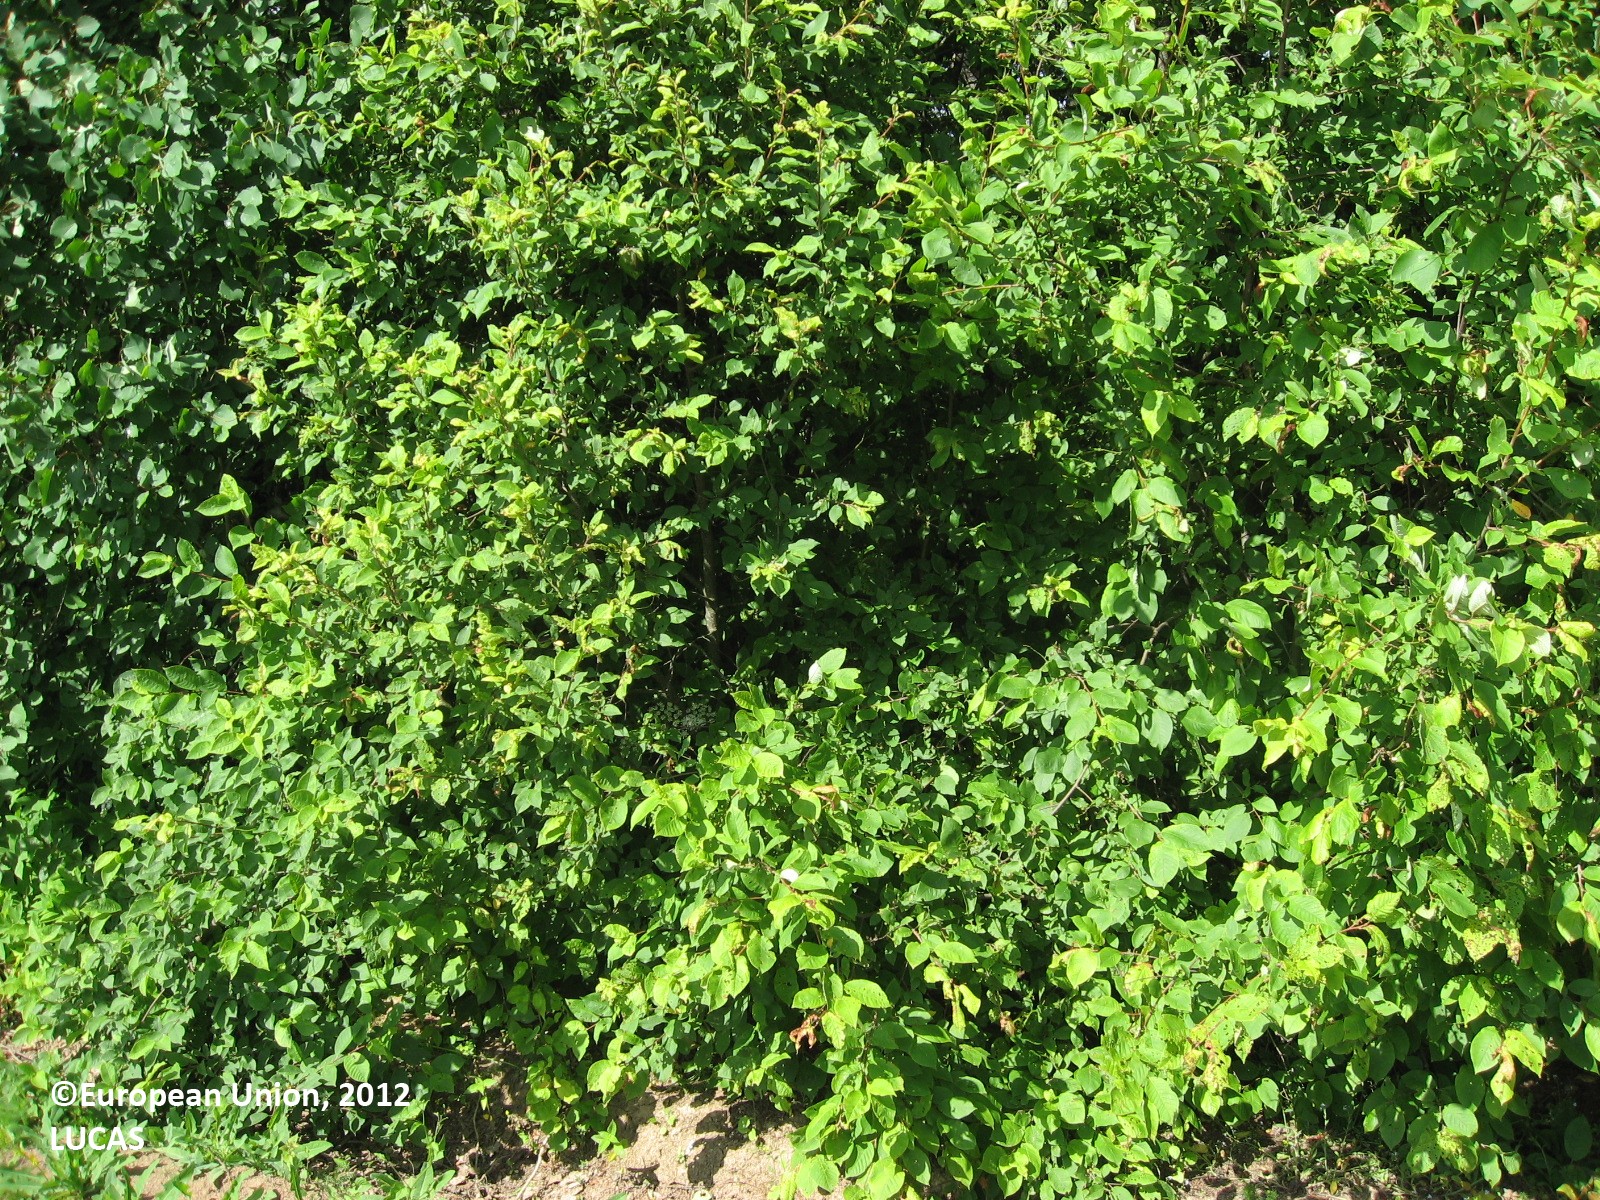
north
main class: Grassland
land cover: Spontaneously vegetated surfaces
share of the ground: 25 - 50 %
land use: Fallow land
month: June
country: FI
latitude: 60.6054
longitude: 26.4647
